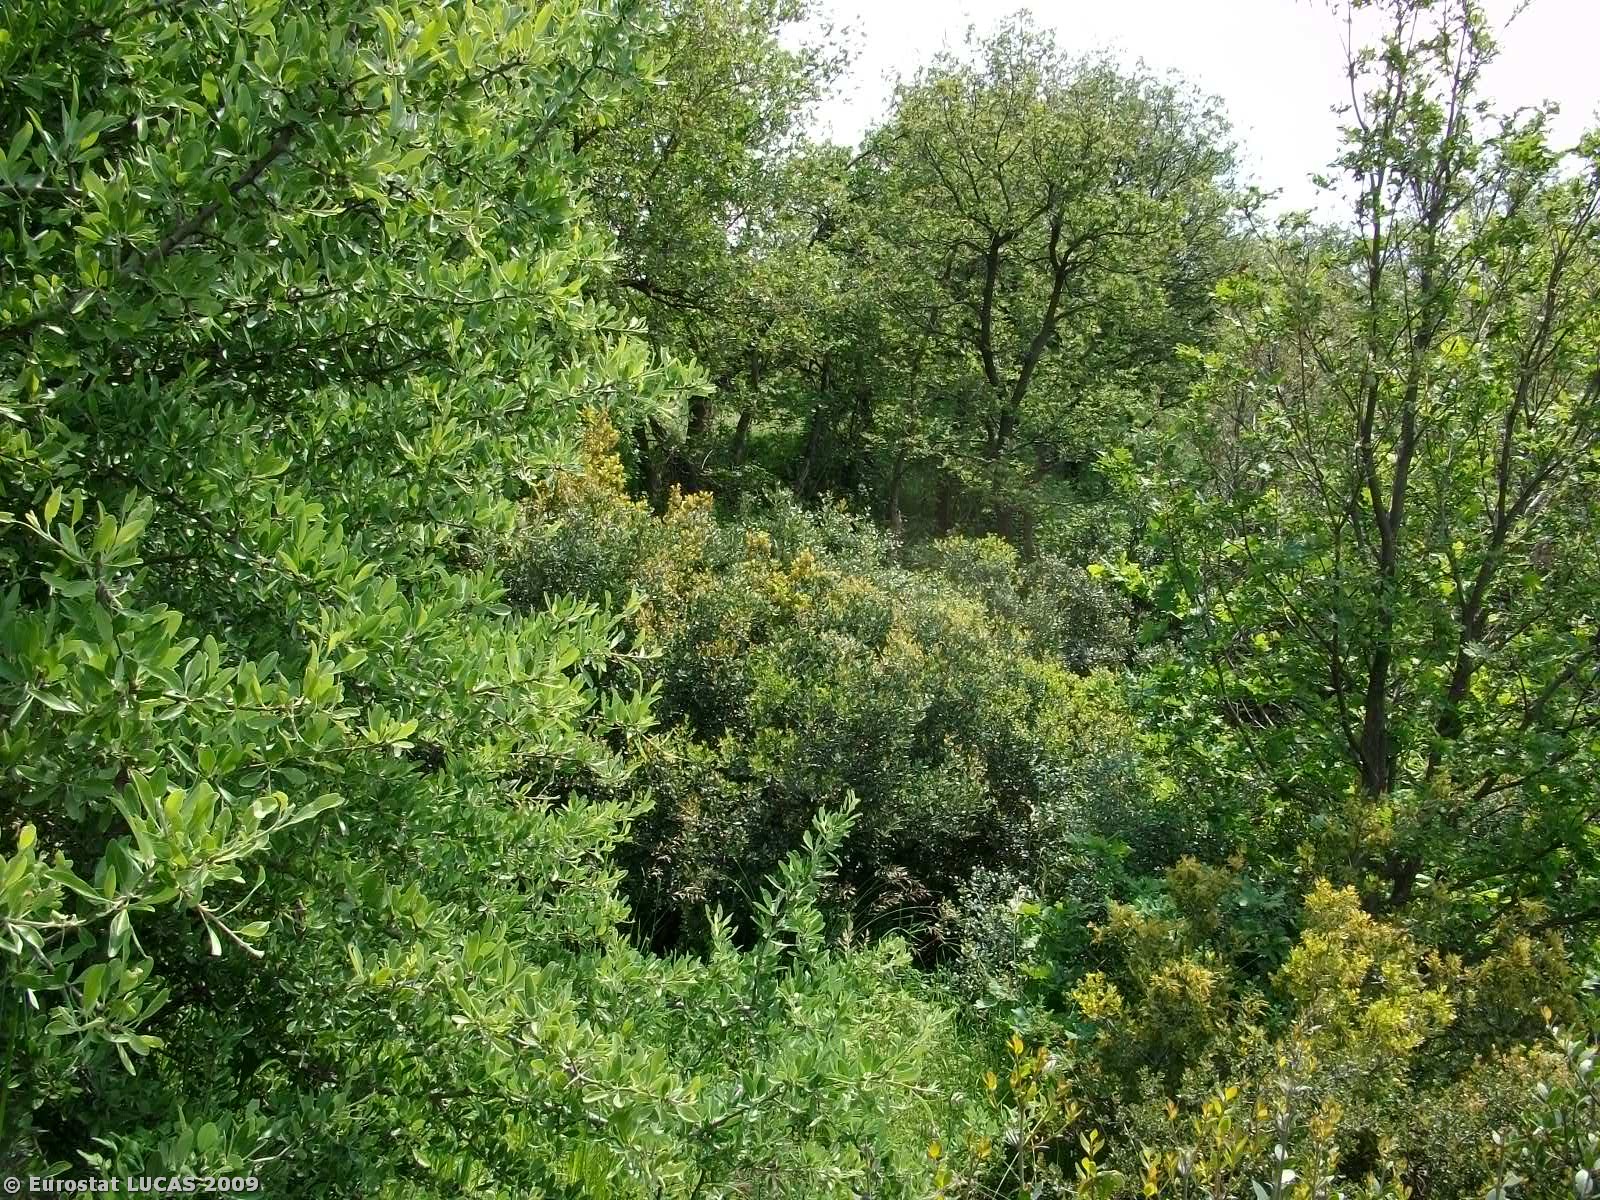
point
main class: Shrubland
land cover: Shrubland with sparse tree cover
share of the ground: > 75 %
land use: Unused
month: May
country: GR
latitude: 39.2079
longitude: 22.5039
